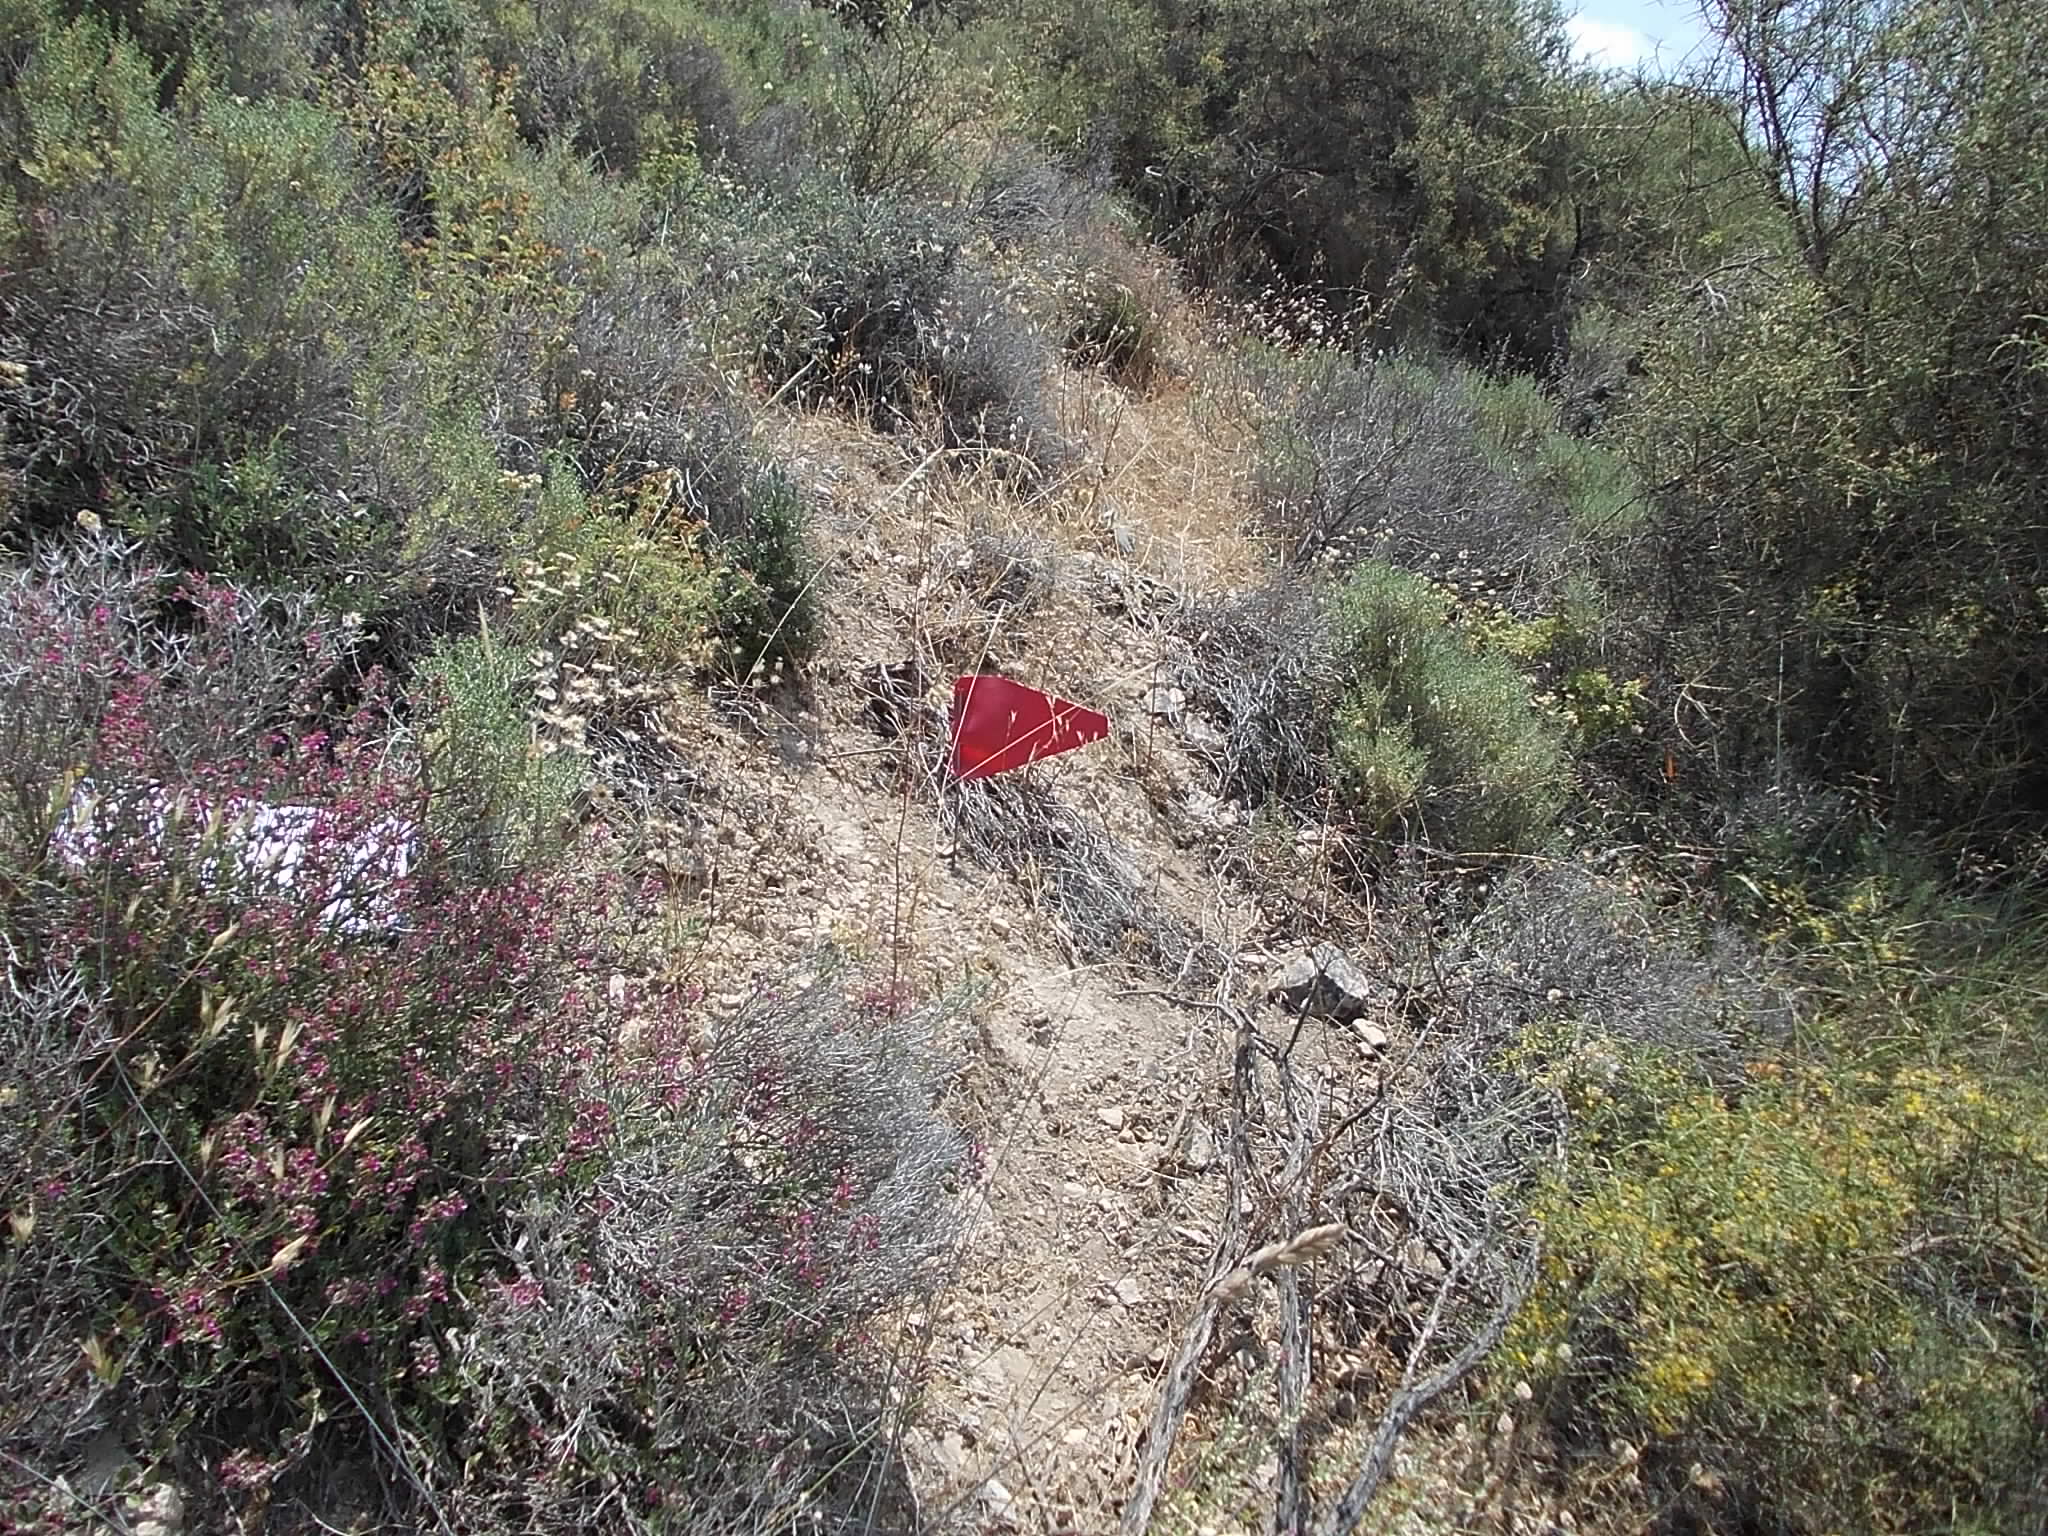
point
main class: Shrubland
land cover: Shrubland without tree cover
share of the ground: > 75 %
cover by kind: shrubs 85 %, herbaceous plants 10 %, unconsolidated bare surface 5 %
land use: Semi-natural and natural areas not in use
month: June
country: CY
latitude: 34.7931
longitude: 32.9300
